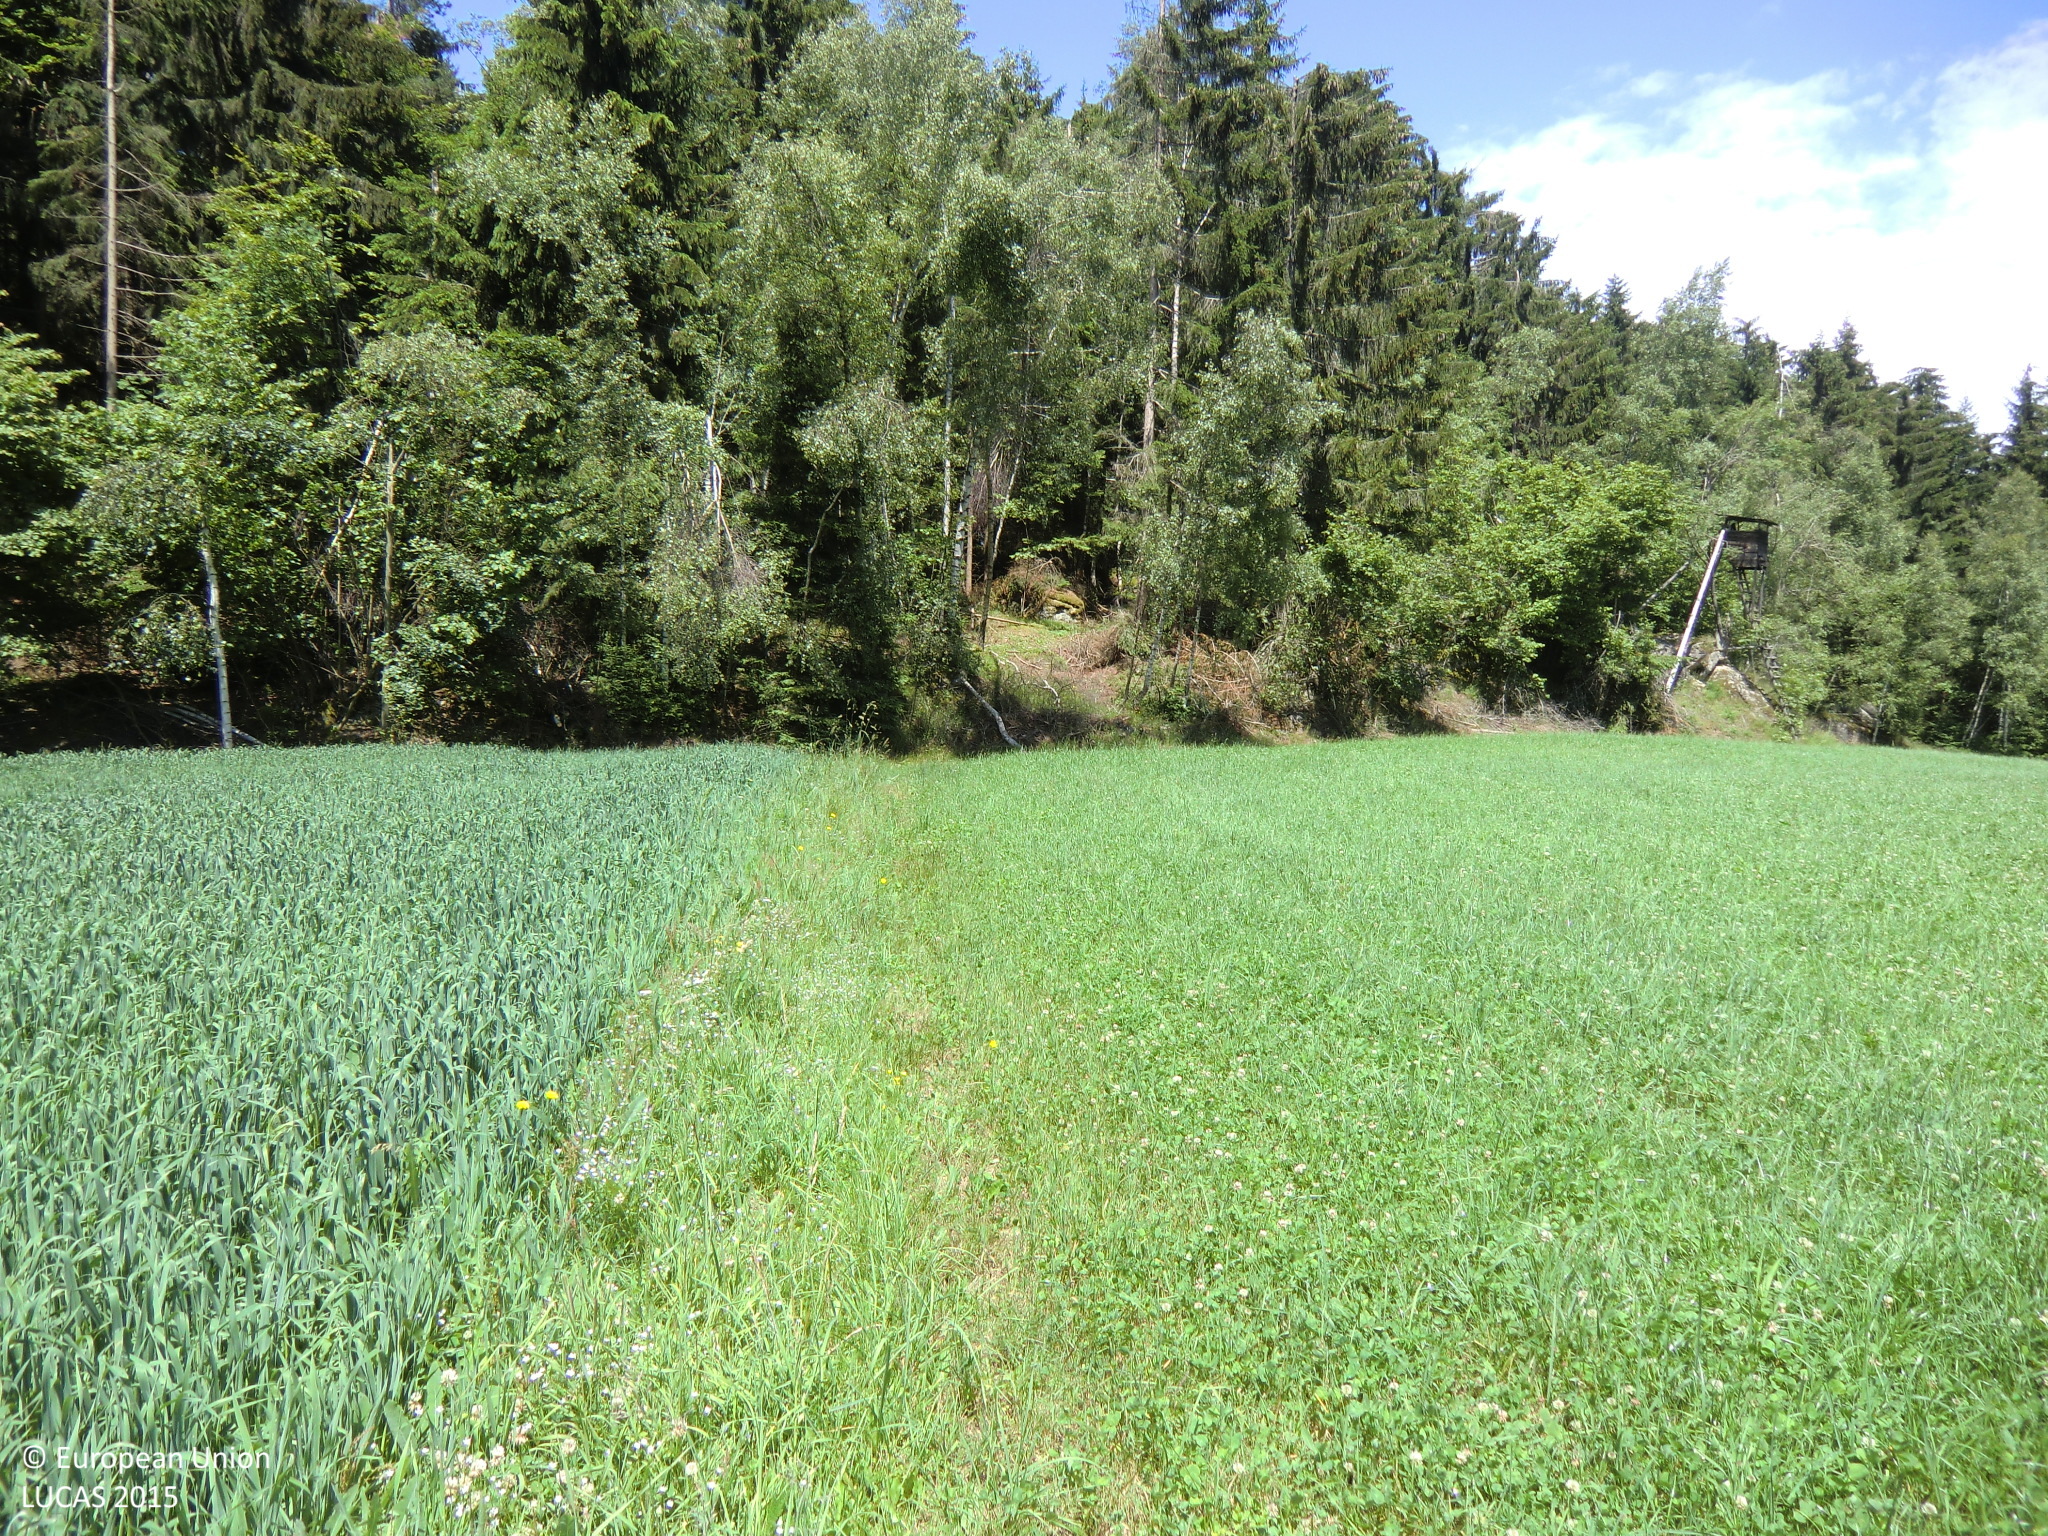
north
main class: Cropland
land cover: Rye
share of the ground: > 75 %
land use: Agriculture (excluding fallow land and kitchen gardens)
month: June
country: AT
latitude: 48.4315
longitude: 15.0700
